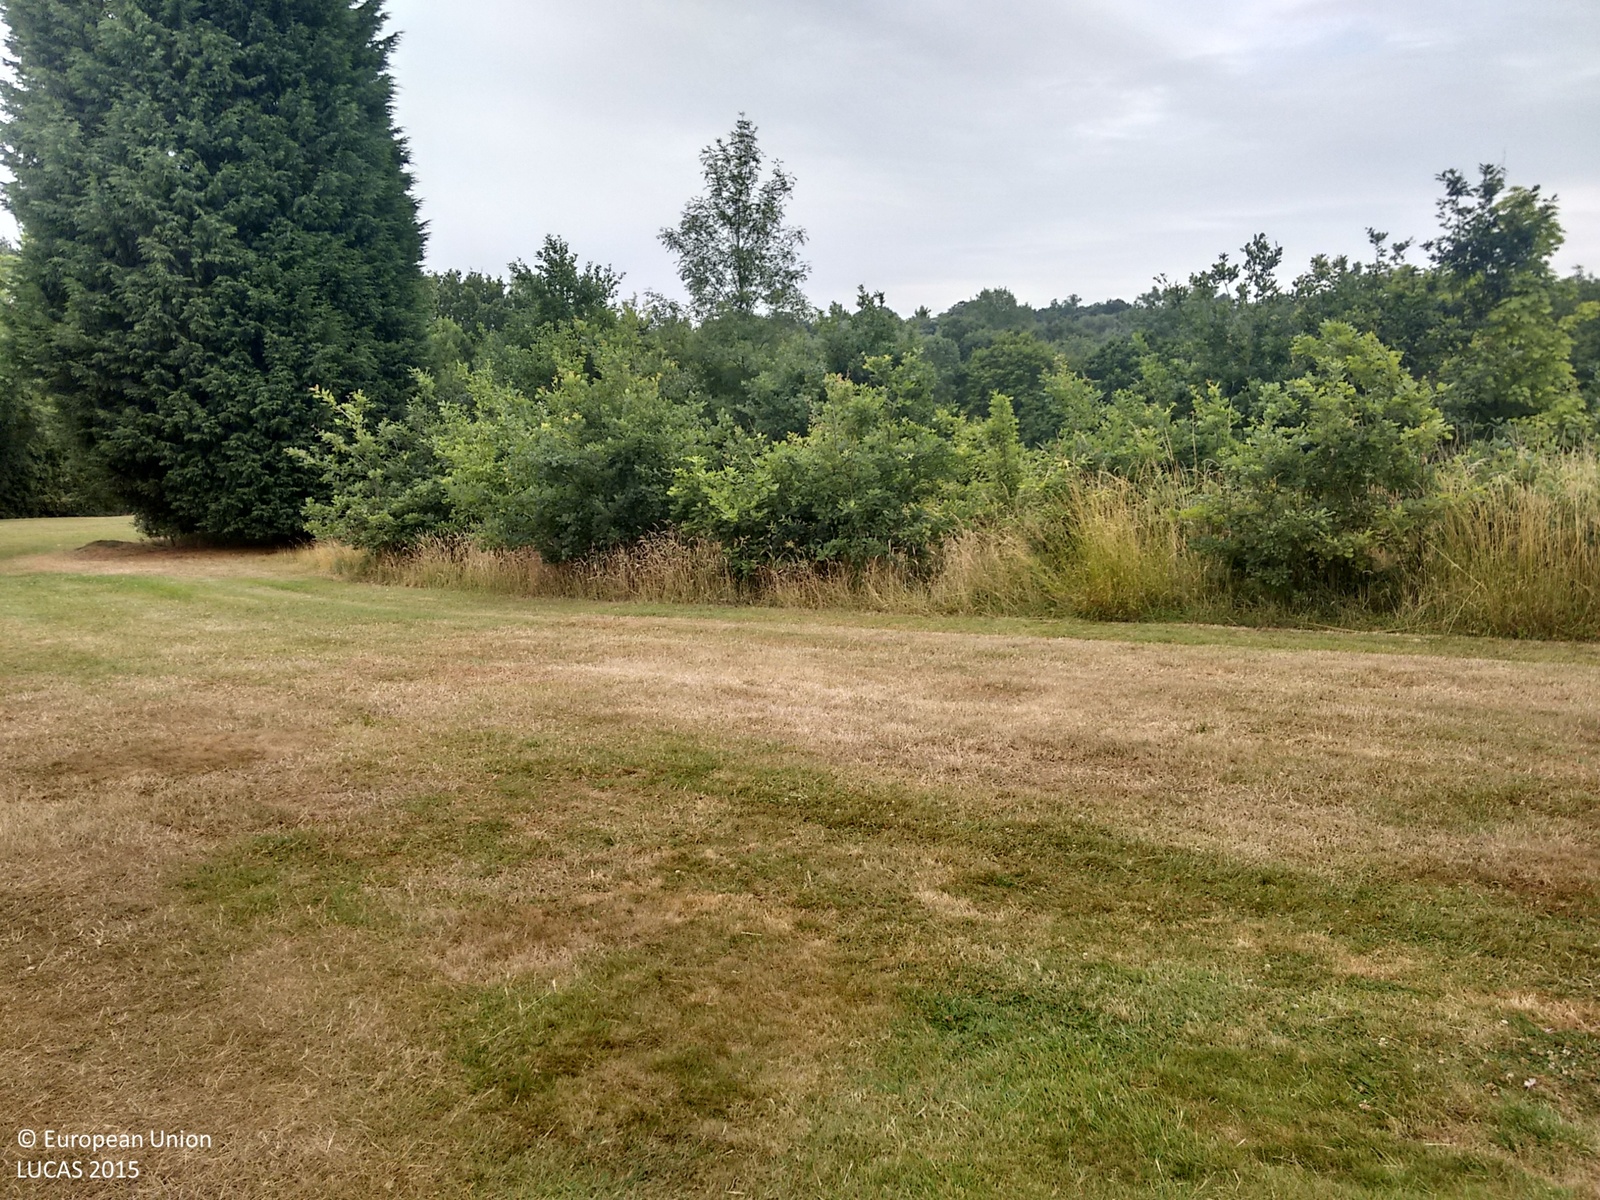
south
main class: Grassland
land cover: Grassland without tree/shrub cover
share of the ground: > 75 %
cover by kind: herbaceous plants 100 %
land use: Sport
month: July
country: GB
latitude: 51.7326
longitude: 0.6049
